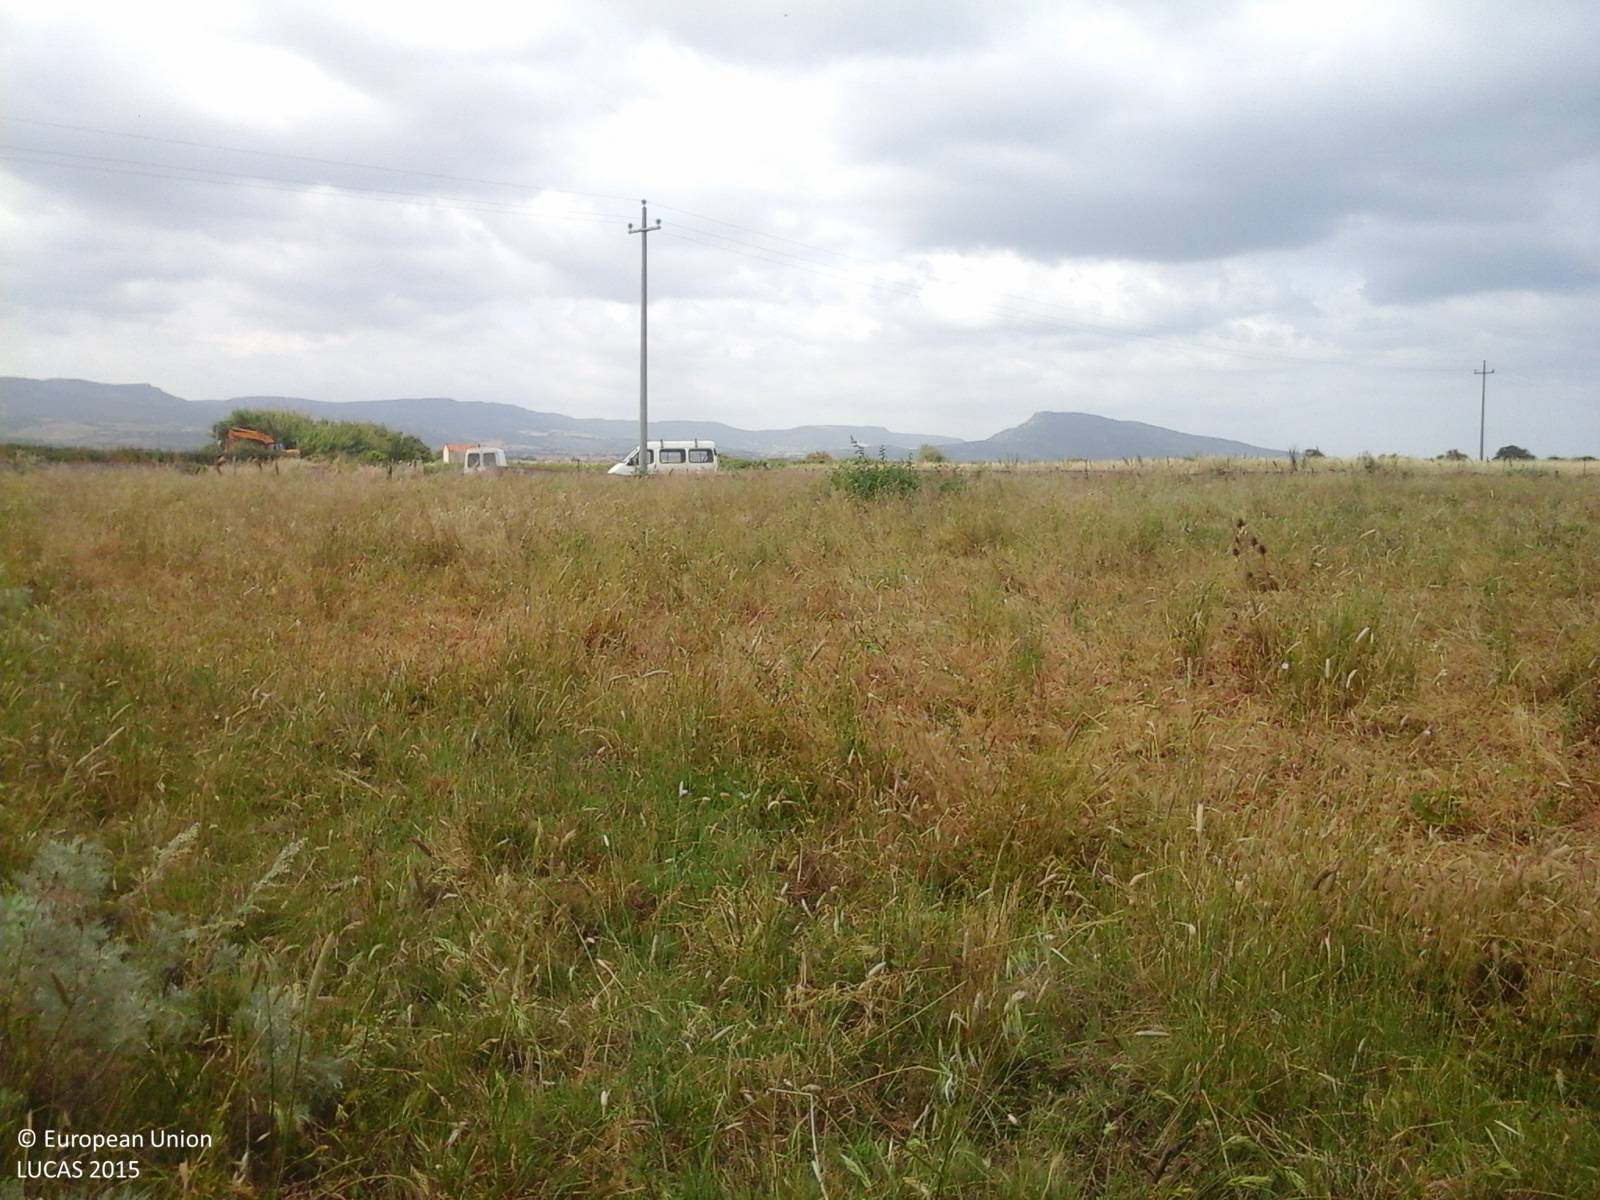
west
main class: Grassland
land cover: Spontaneously vegetated surfaces
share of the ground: > 75 %
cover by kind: herbaceous plants 100 %
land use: Agriculture (excluding fallow land and kitchen gardens)
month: May
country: IT
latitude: 40.9483
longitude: 8.8531
